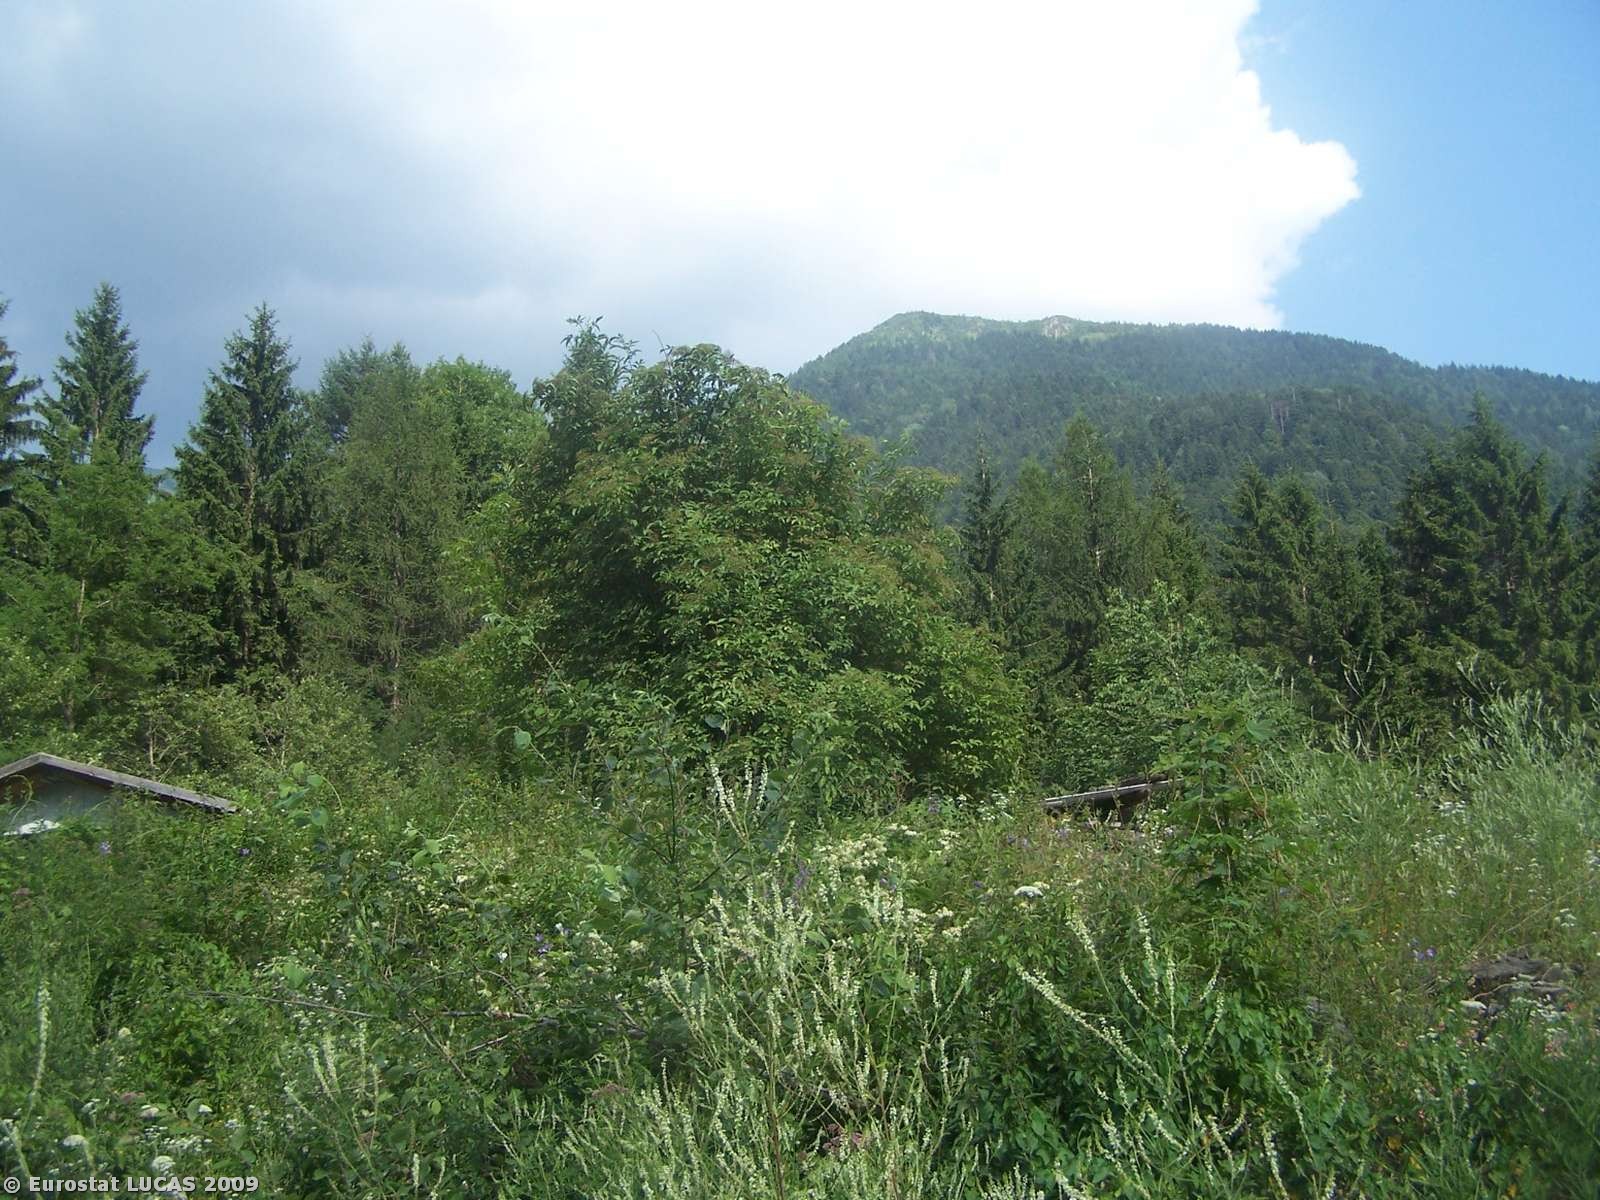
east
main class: Grassland
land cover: Spontaneously vegetated surfaces
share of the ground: 50 - 75 %
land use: Mining and quarrying
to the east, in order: Spontaneously vegetated surfaces; Artificial constructions in urban areas; Fences; Mixed woodland; Fences; Tracks; Mixed woodland; Grassland without tree/shrub cover; Mixed woodland; Grassland without tree/shrub cover
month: July
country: IT
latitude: 46.5612
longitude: 13.0105
